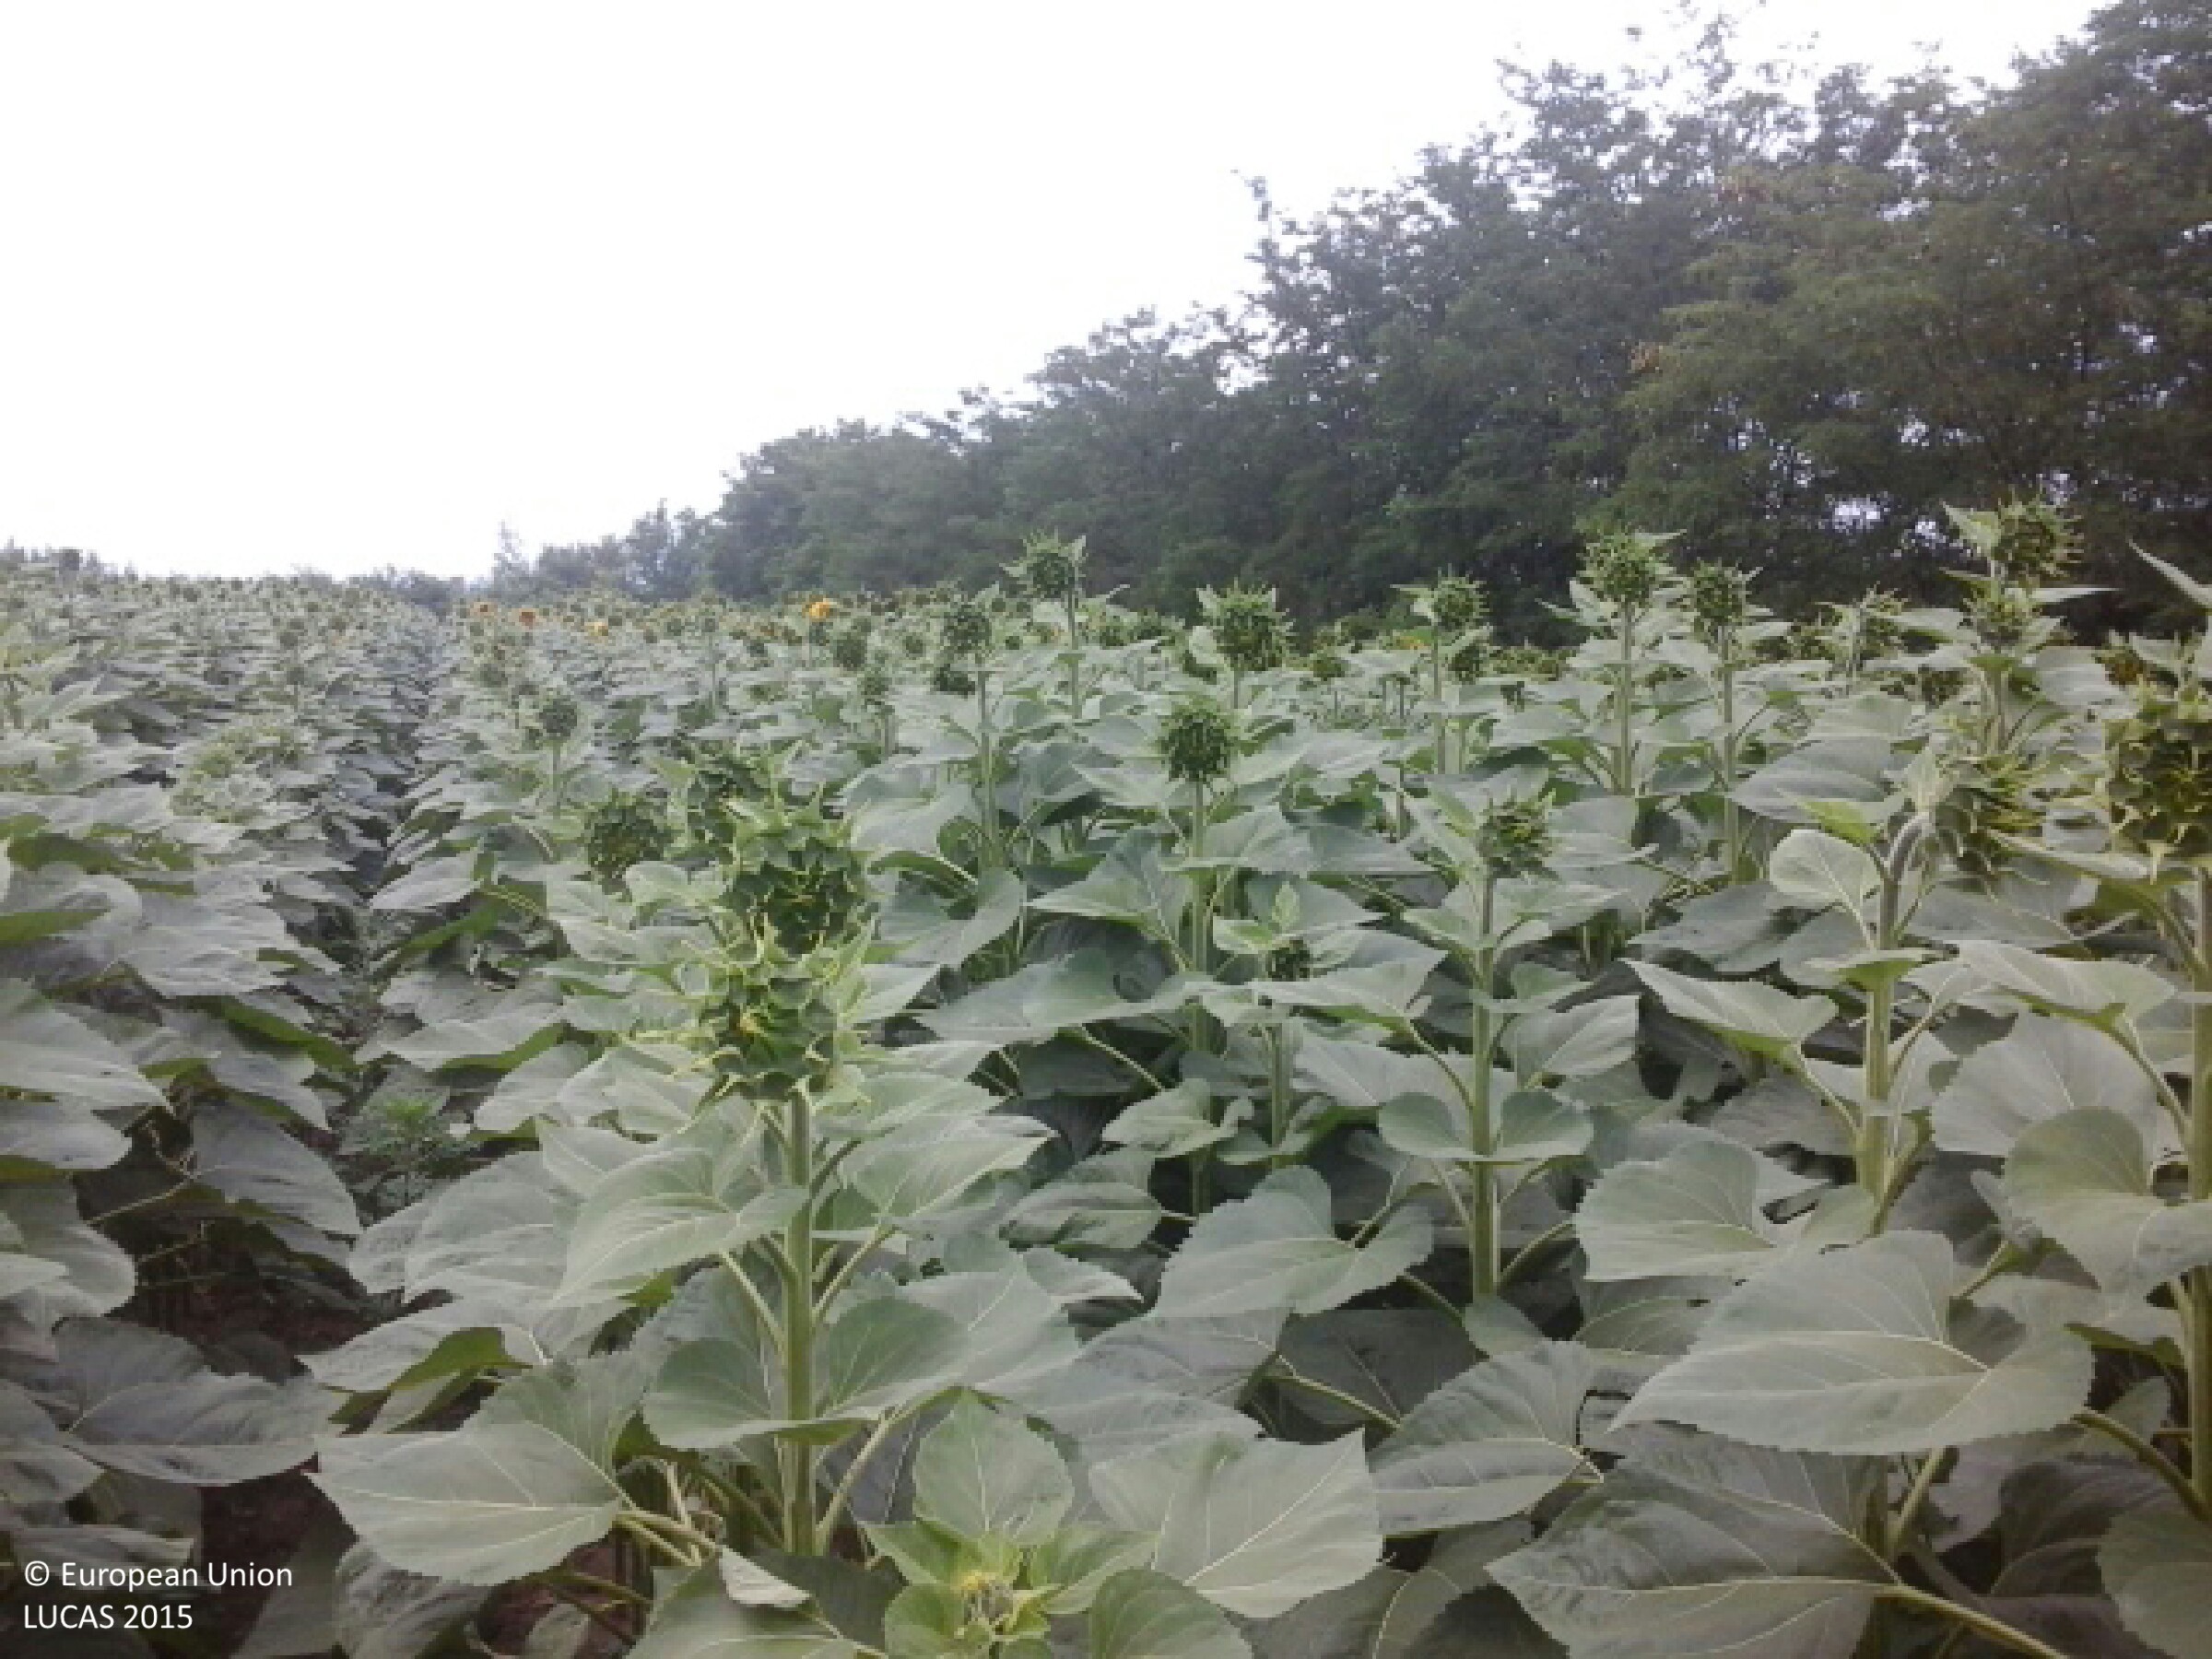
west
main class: Cropland
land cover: Sunflower
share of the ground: > 75 %
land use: Agriculture (excluding fallow land and kitchen gardens)
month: June
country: HU
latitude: 48.1679
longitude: 21.9792
